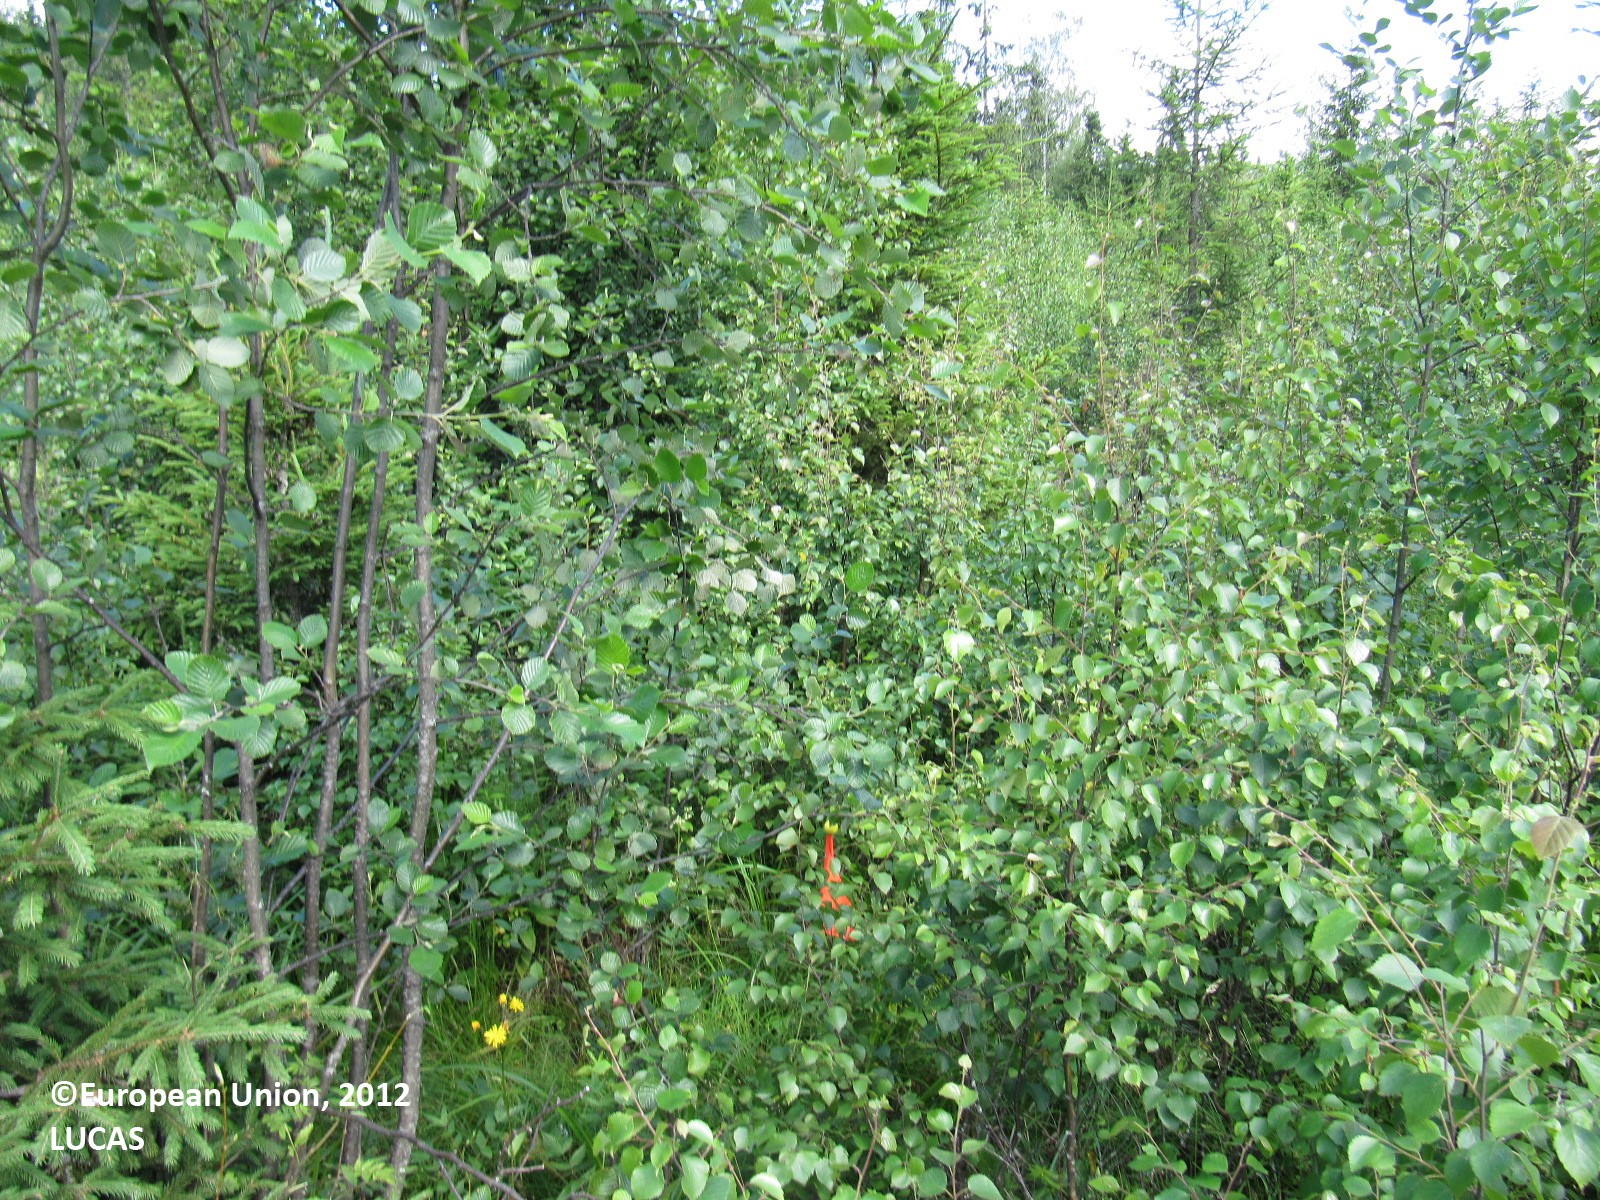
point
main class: Woodland
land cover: Broadleaved woodland
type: boreal forest
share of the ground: > 75 %
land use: Forestry
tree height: < 5 m
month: July
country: FI
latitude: 60.9800
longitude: 24.1961
